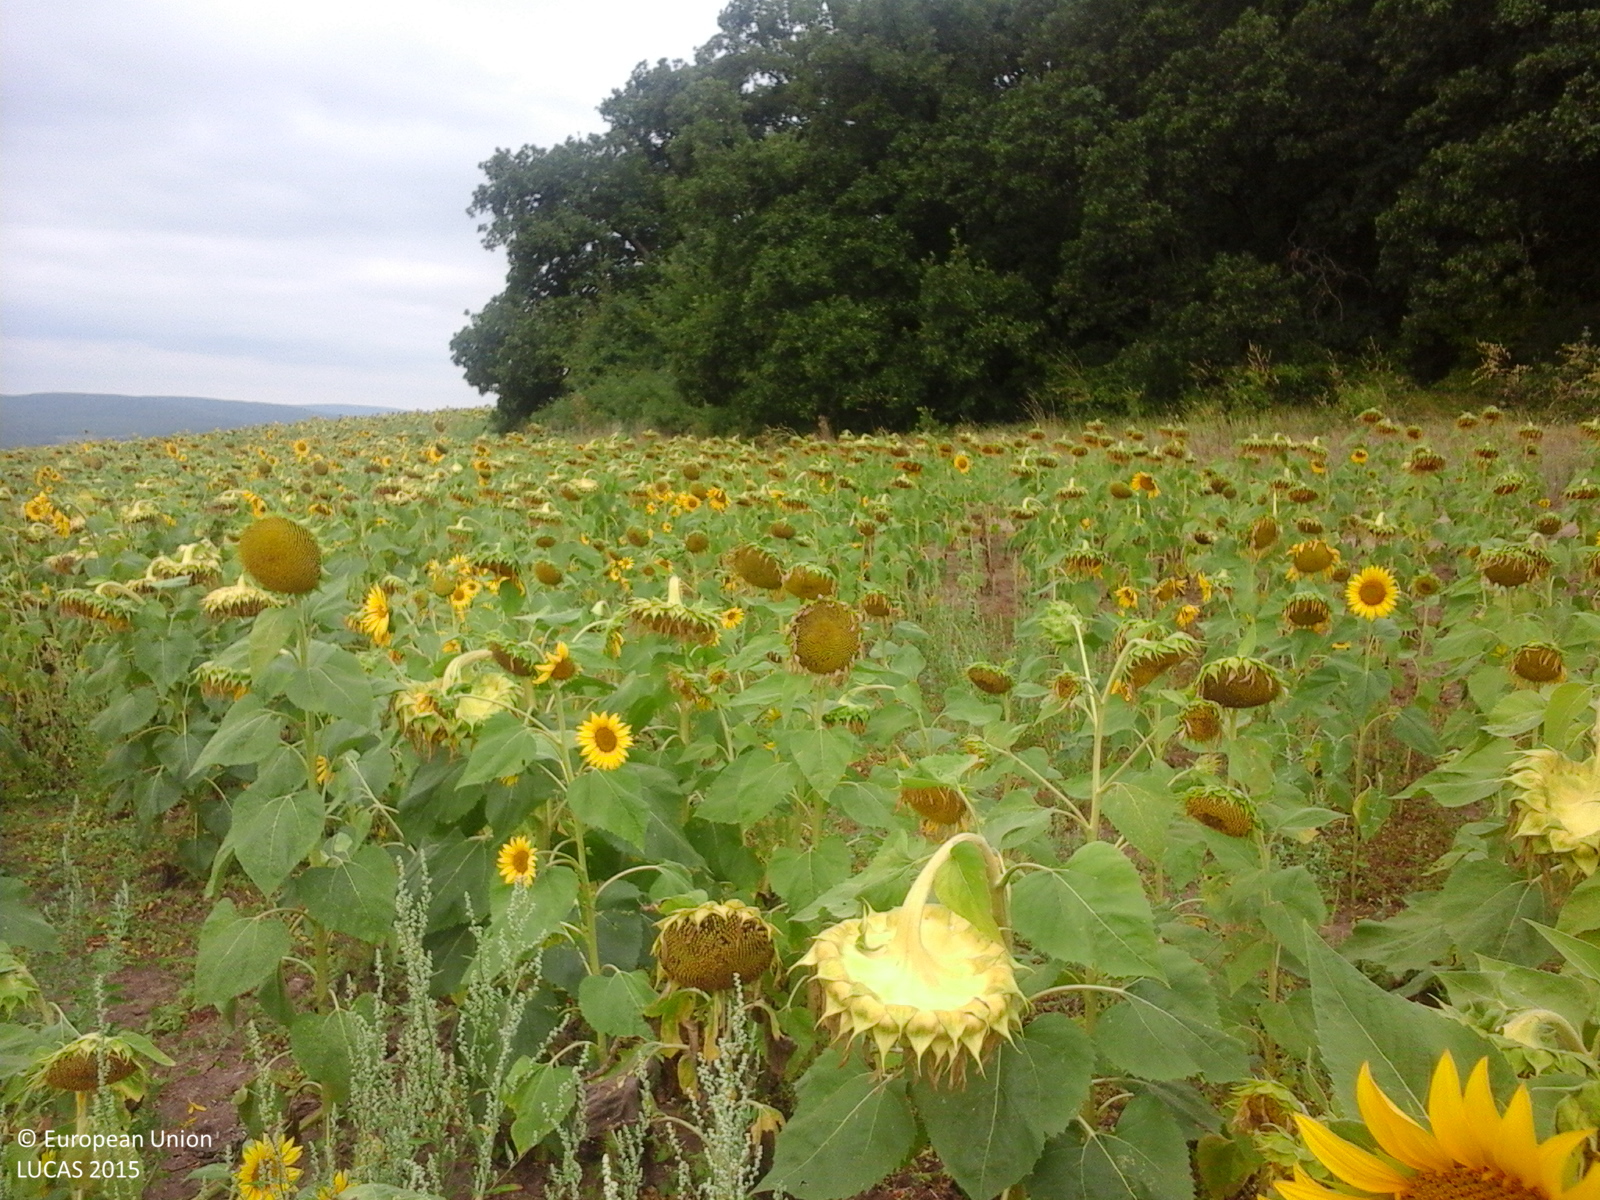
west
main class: Cropland
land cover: Sunflower
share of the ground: > 75 %
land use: Agriculture (excluding fallow land and kitchen gardens)
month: August
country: RO
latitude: 44.8587
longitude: 28.6462
